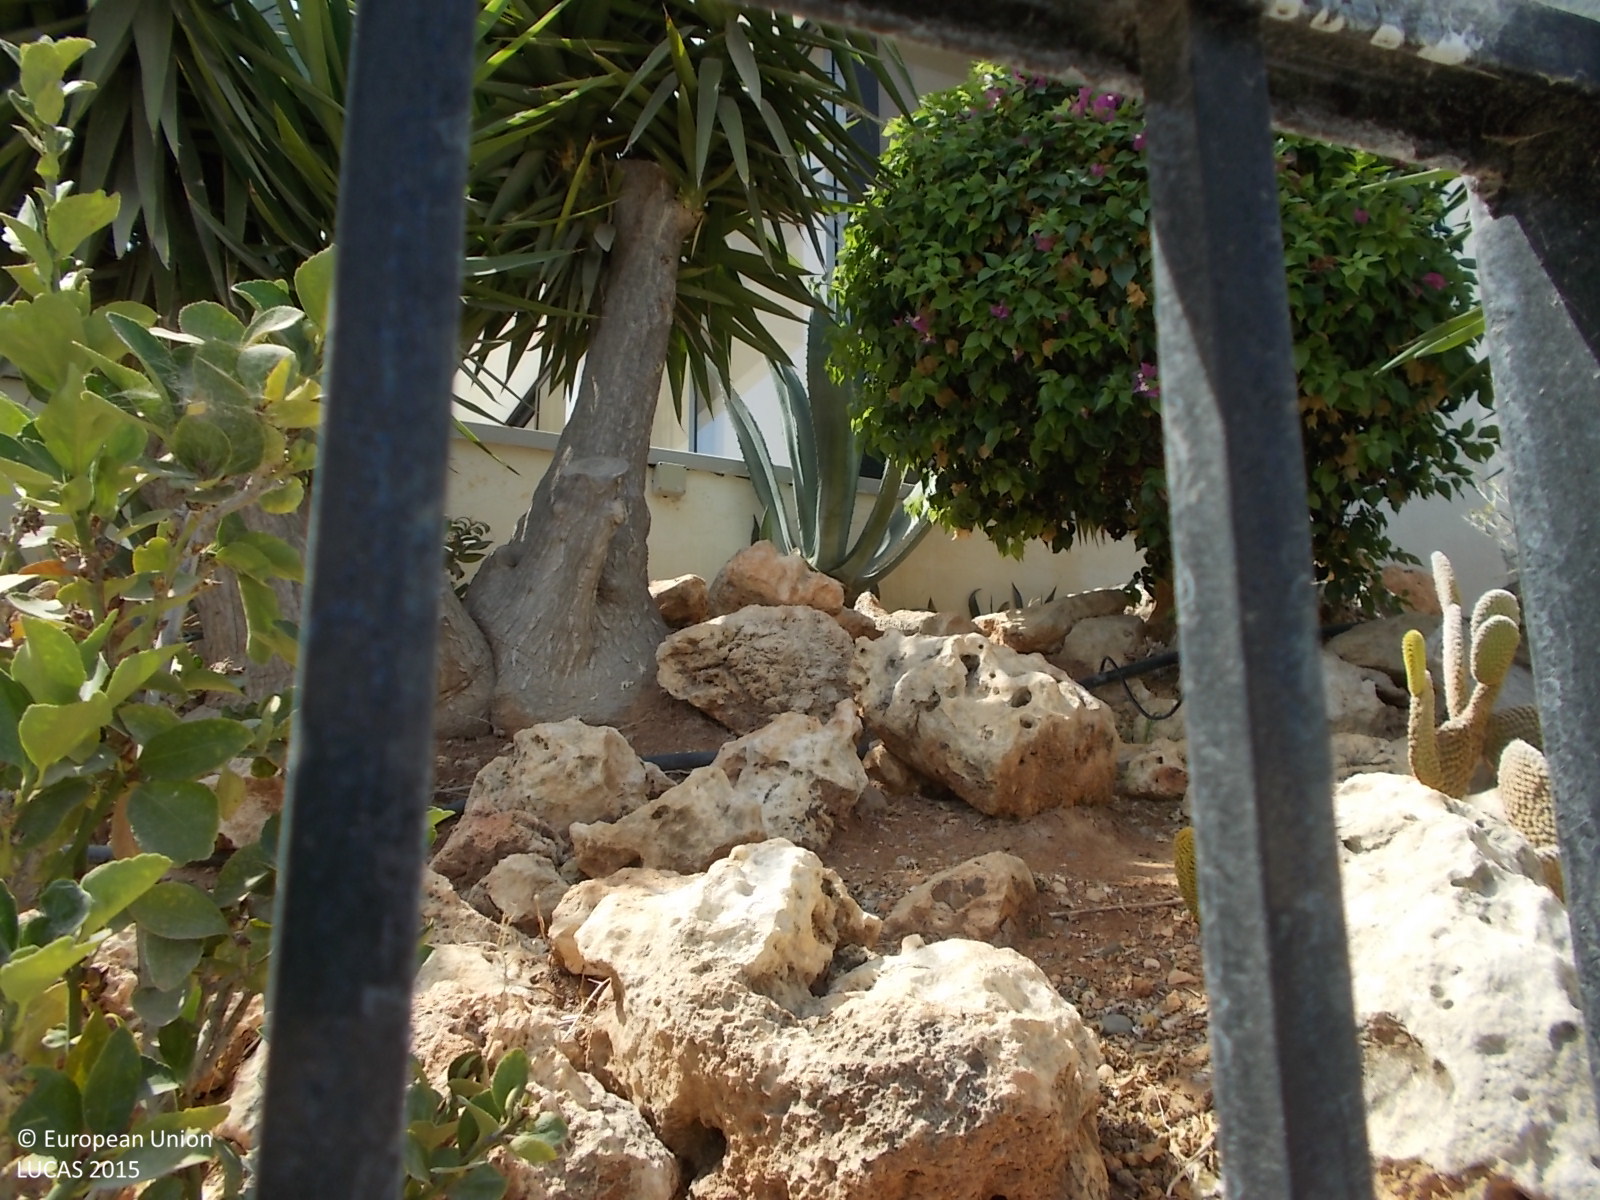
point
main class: Woodland
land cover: Broadleaved woodland
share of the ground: 50 - 75 %
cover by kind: broadleaved forest trees 70 %, unconsolidated bare surface 20 %, consolidated bare surface 10 %
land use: Residential
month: April
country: CY
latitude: 34.7101
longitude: 33.1078
